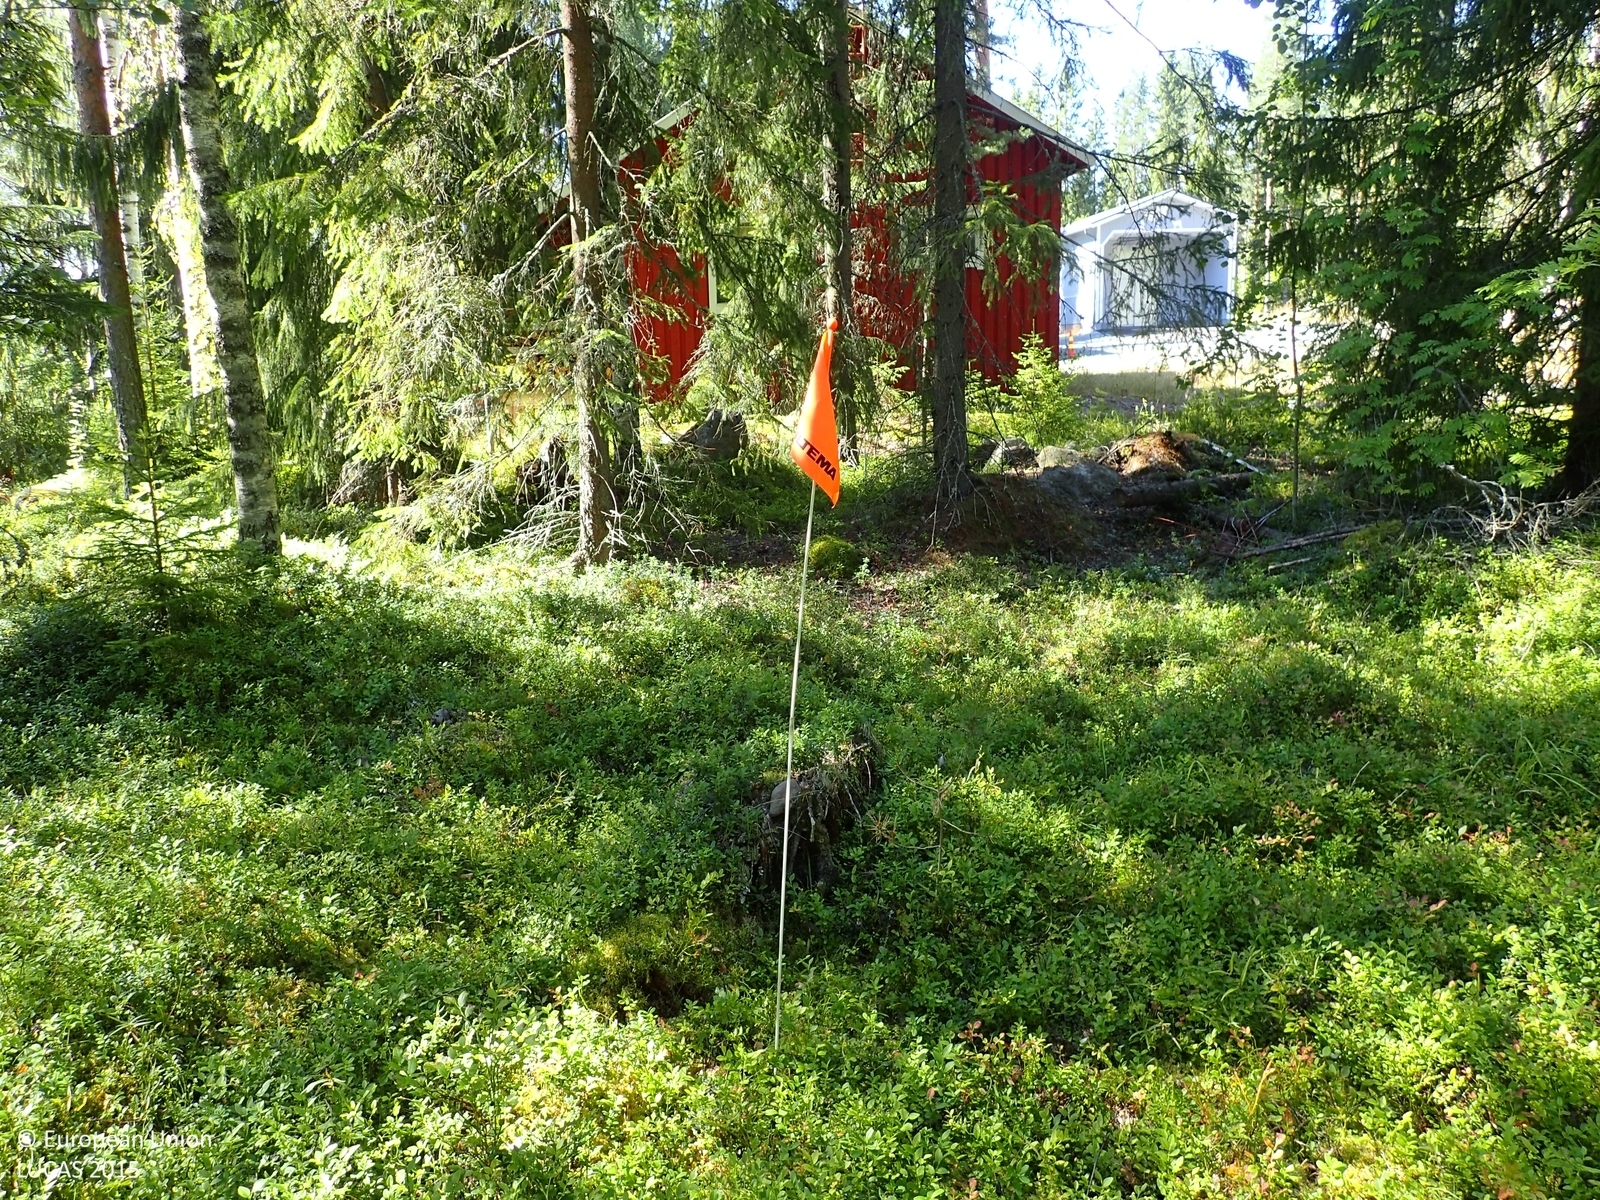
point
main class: Woodland
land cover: Other mixed woodland
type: boreal forest
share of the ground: > 75 %
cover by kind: coniferous forest trees 55 %, shrubs 25 %, broadleaved forest trees 20 %
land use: Forestry
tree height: > 5 m
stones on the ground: < 10 %
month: August
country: FI
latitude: 62.5001
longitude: 22.6173
